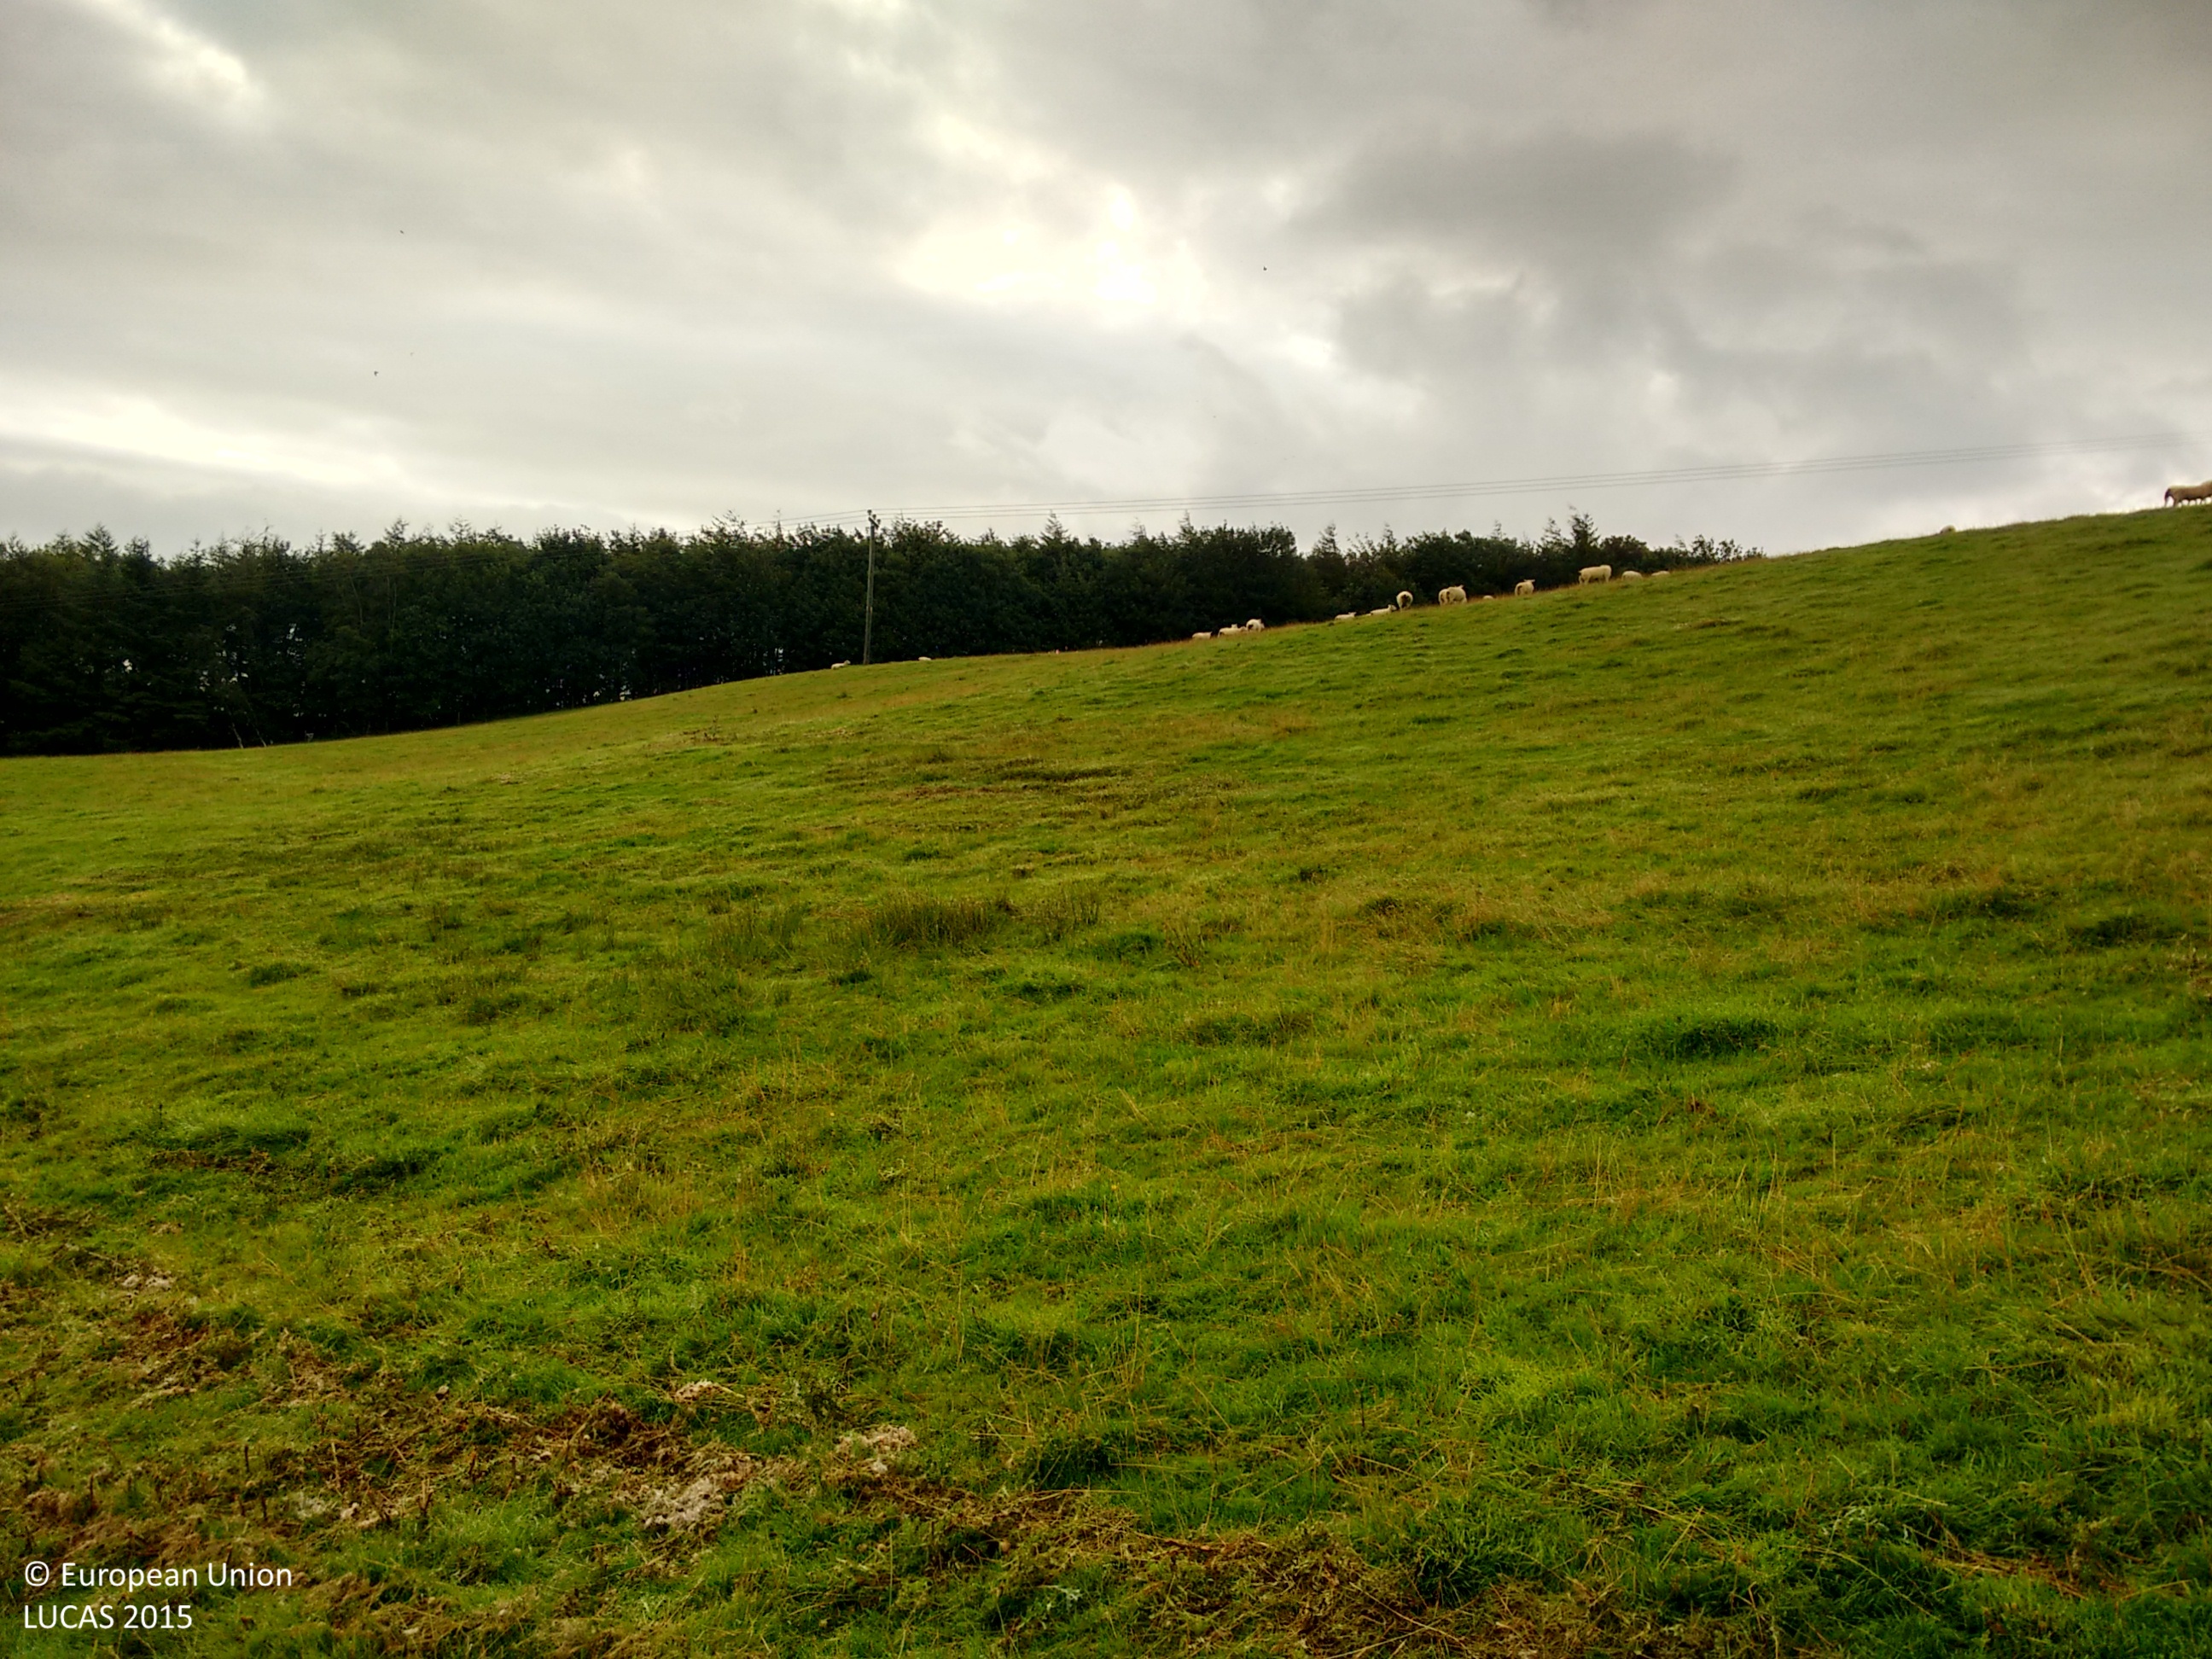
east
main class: Grassland
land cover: Grassland with sparse tree/shrub cover
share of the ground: > 75 %
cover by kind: herbaceous plants 95 %, broadleaved forest trees 5 %
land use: Semi-natural and natural areas not in use
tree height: > 5 m
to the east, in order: Grassland with sparse tree/shrub cover; Fences; Grassland without tree/shrub cover; Electric lines; Grassland without tree/shrub cover; Fences; Spruce dominated mixed woodland; Fences; Grassland without tree/shrub cover; Fences; Grassland without tree/shrub cover; Grass margins; Tracks; Grassland without tree/shrub cover
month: August
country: GB
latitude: 54.6841
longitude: -3.3405
